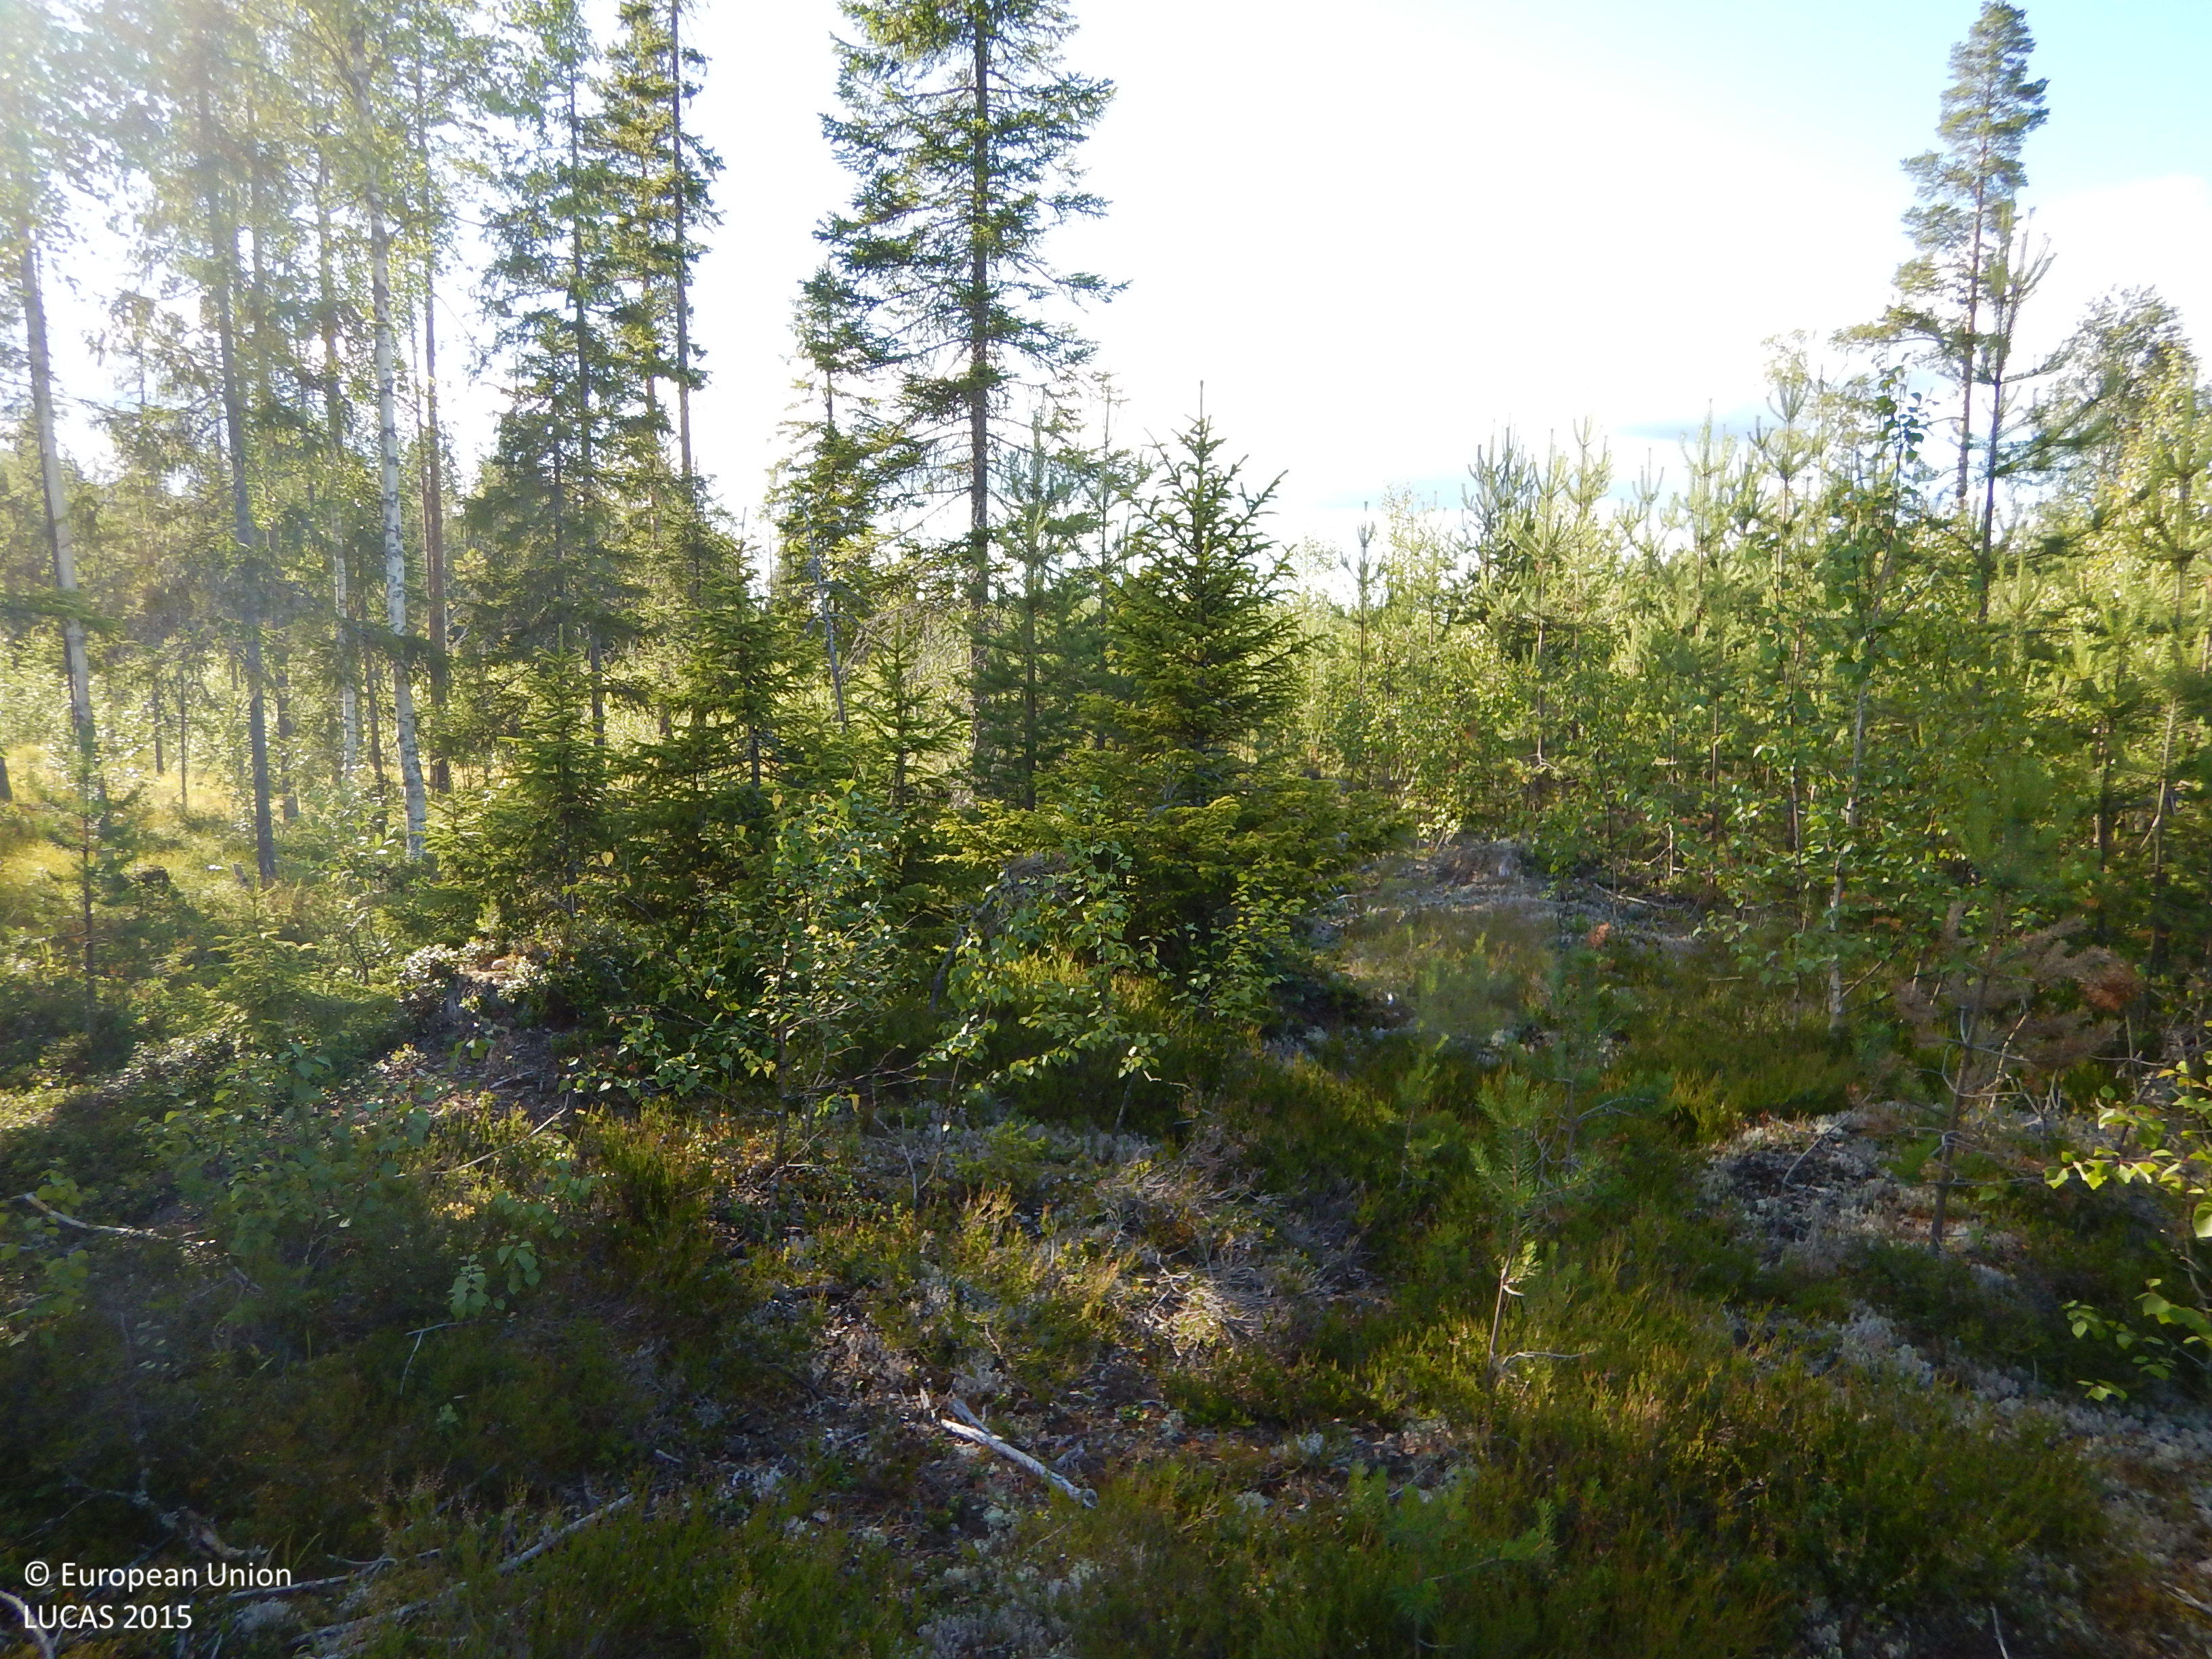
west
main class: Woodland
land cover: Pine dominated mixed woodland
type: boreal forest
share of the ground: 25 - 50 %
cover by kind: coniferous forest trees 25 %, shrubs 25 %, broadleaved forest trees 20 %, herbaceous plants 20 %, lichens and mosses 10 %
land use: Forestry
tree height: < 5 m
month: July
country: SE
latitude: 64.8071
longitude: 20.9046
